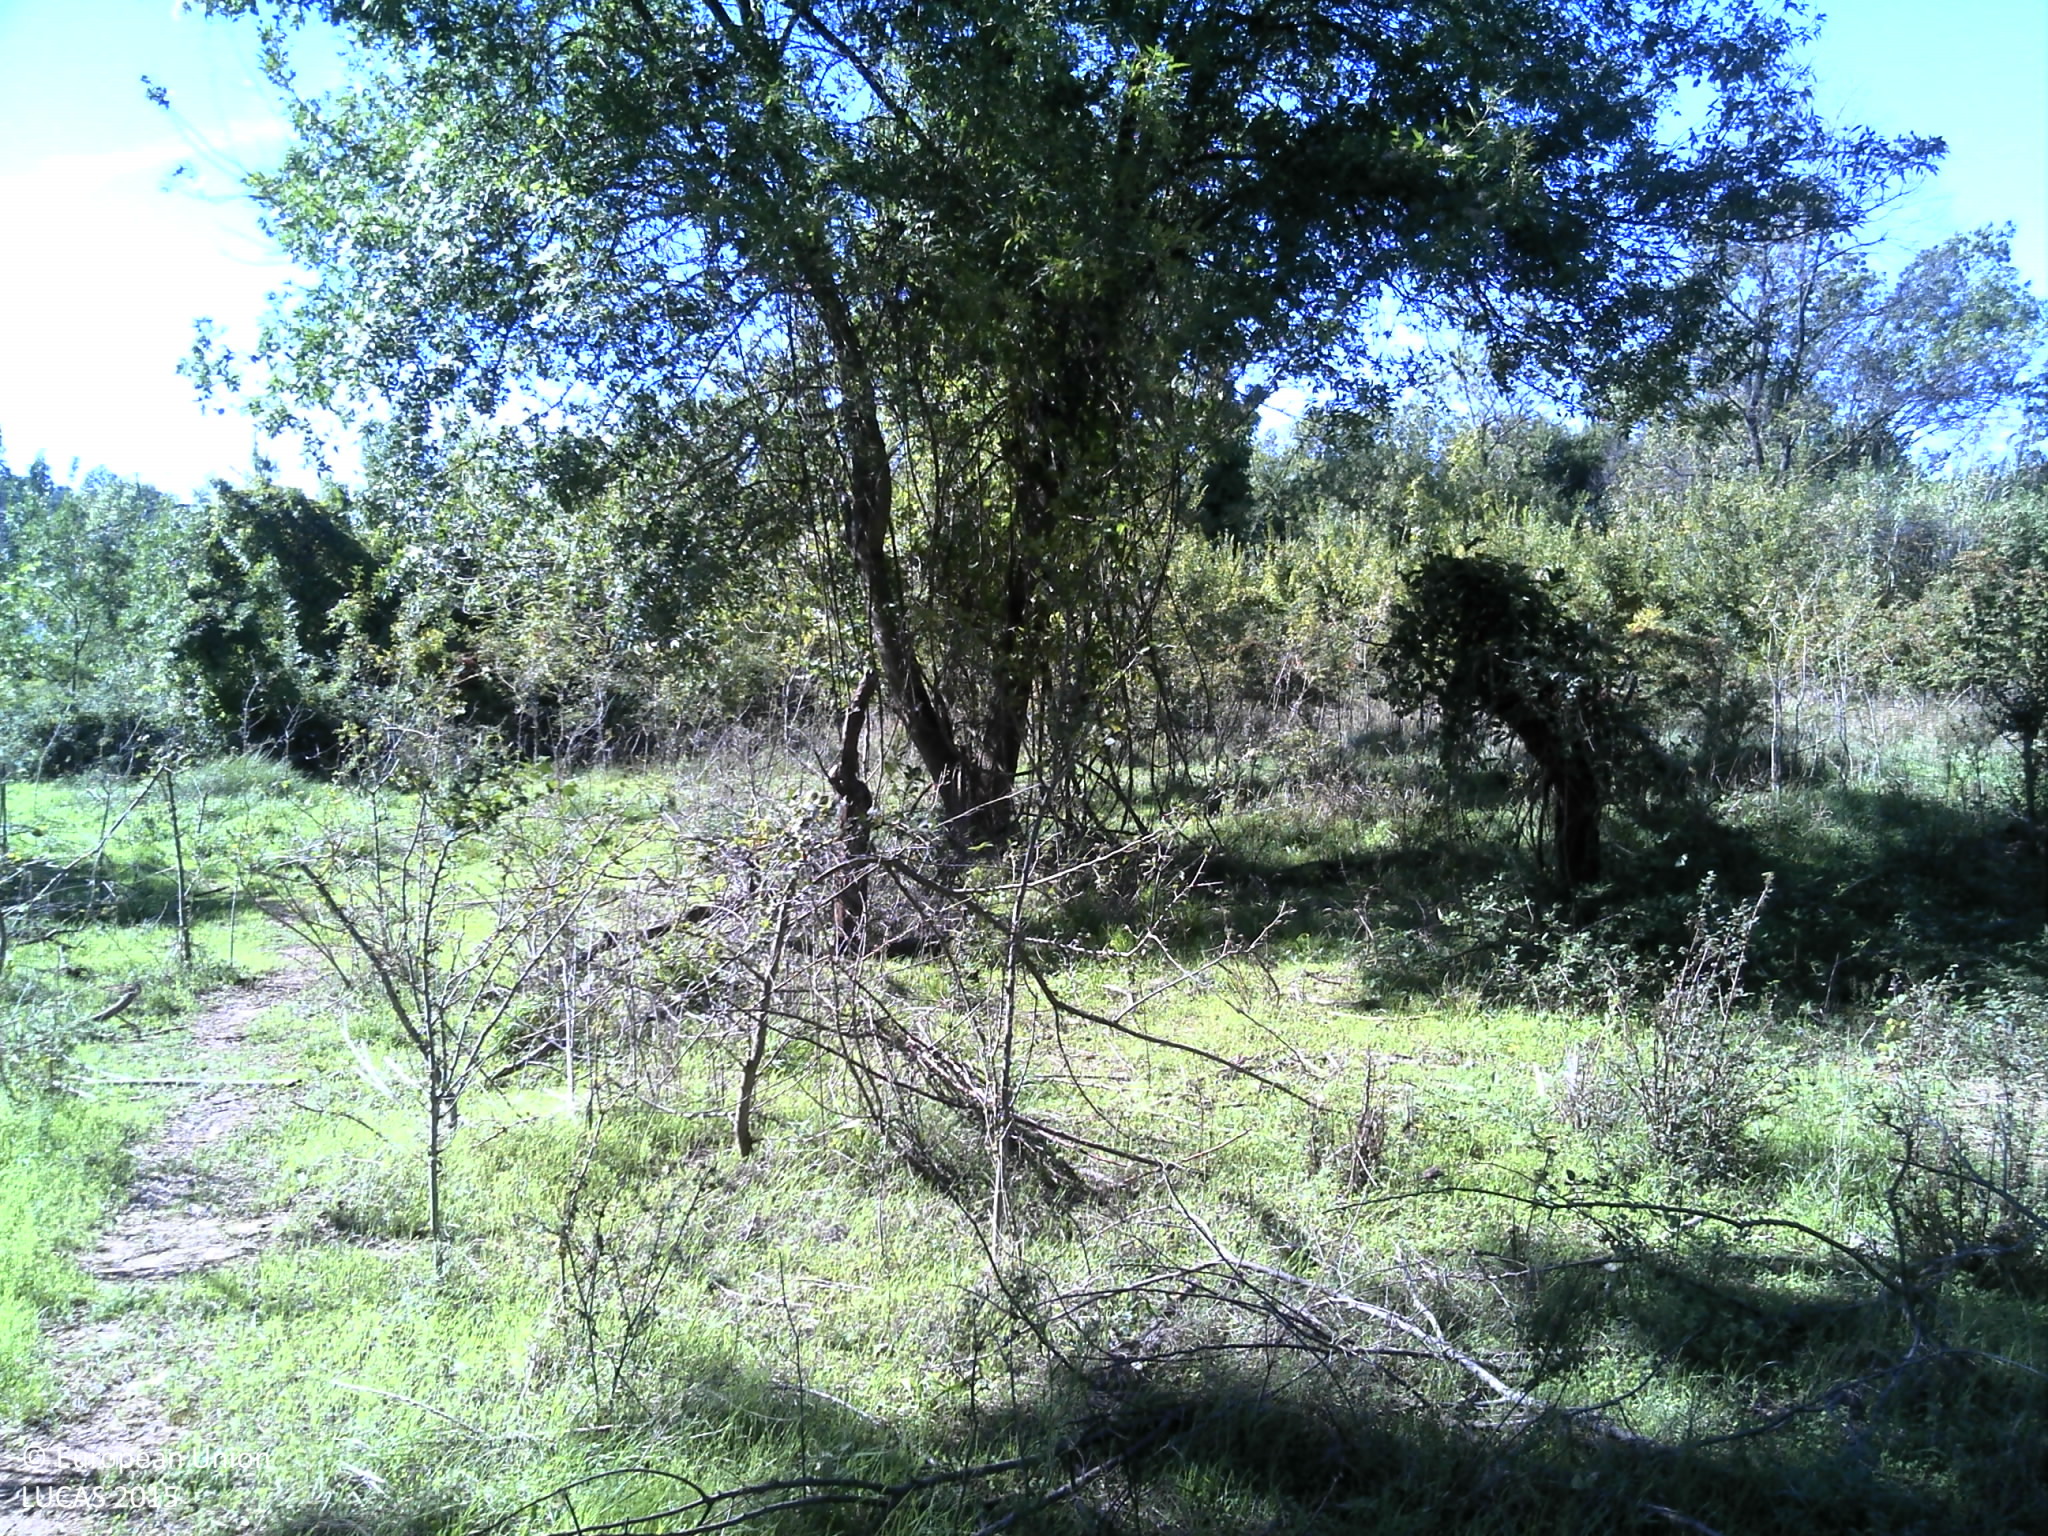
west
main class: Woodland
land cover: Broadleaved woodland
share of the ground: > 75 %
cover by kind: broadleaved forest trees 60 %, herbaceous plants 30 %, shrubs 10 %
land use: Forestry
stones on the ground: < 10 %
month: October
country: FR
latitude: 43.4638
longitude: 6.5847
